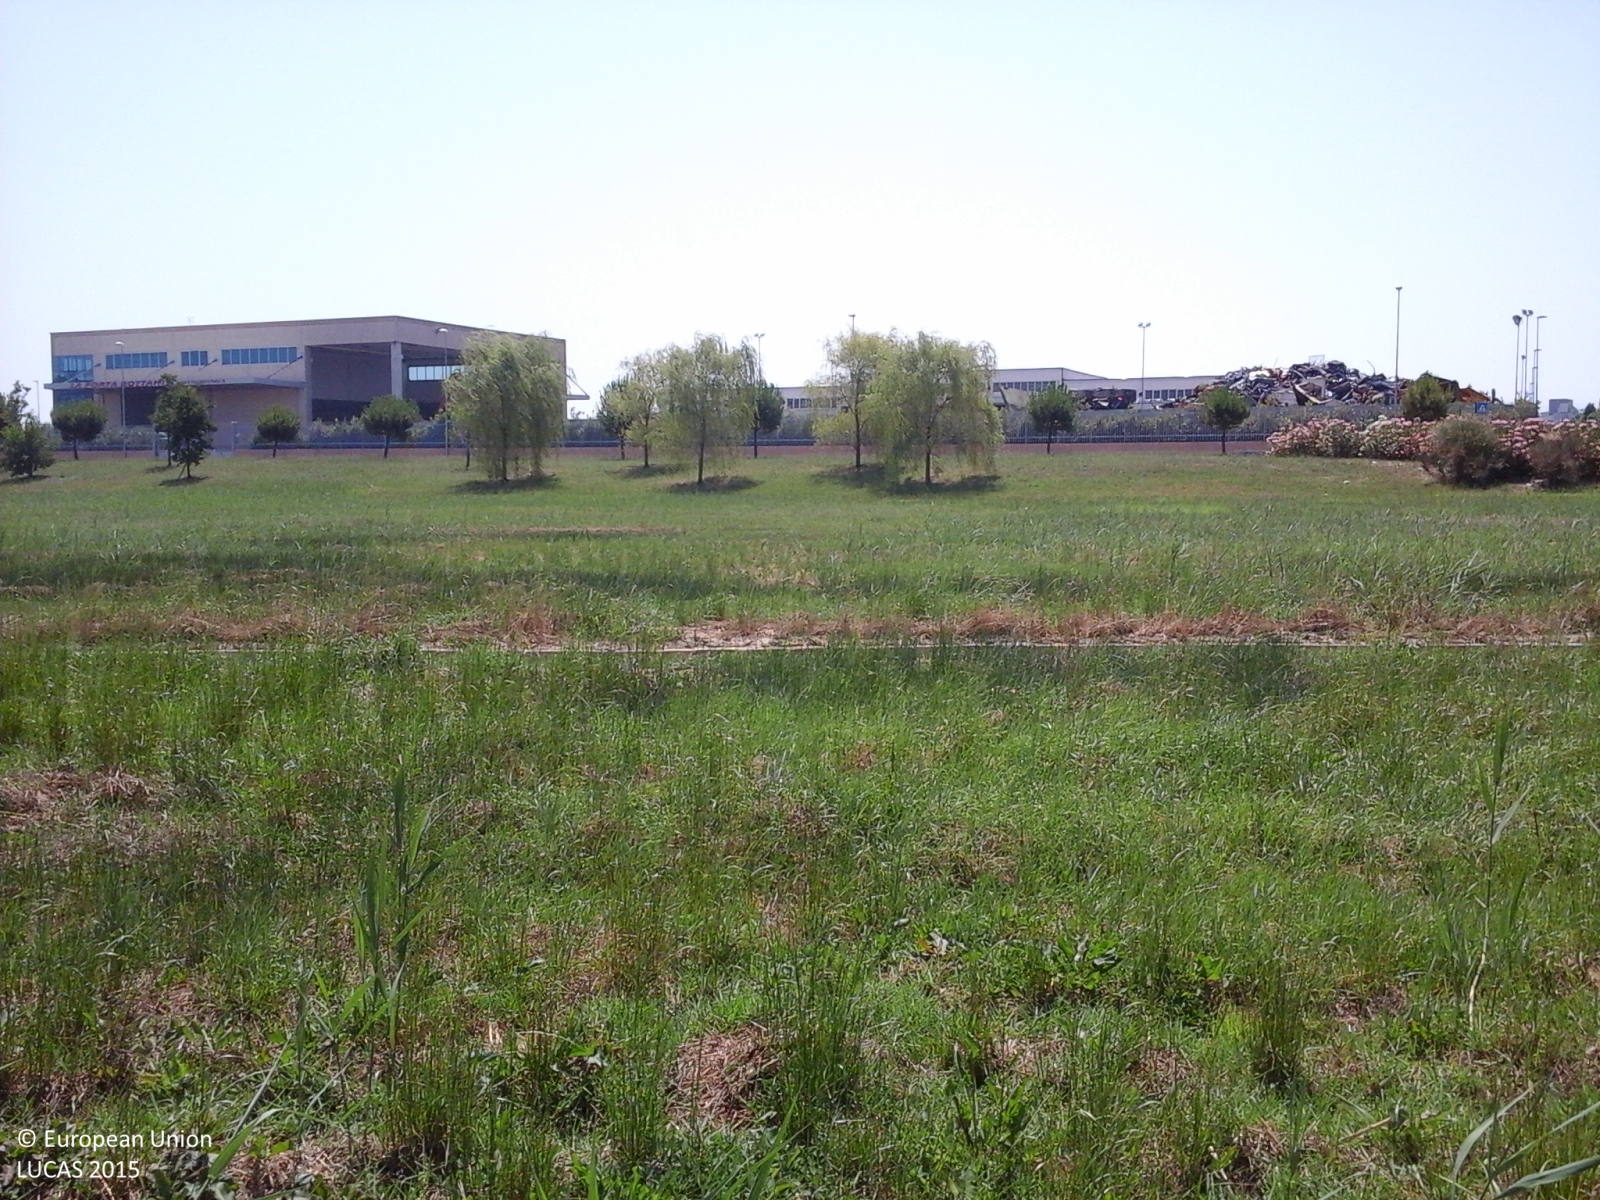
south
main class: Grassland
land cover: Spontaneously vegetated surfaces
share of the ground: > 75 %
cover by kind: herbaceous plants 100 %
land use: Fallow land
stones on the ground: < 10 %
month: July
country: IT
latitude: 44.1073
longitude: 12.3559
